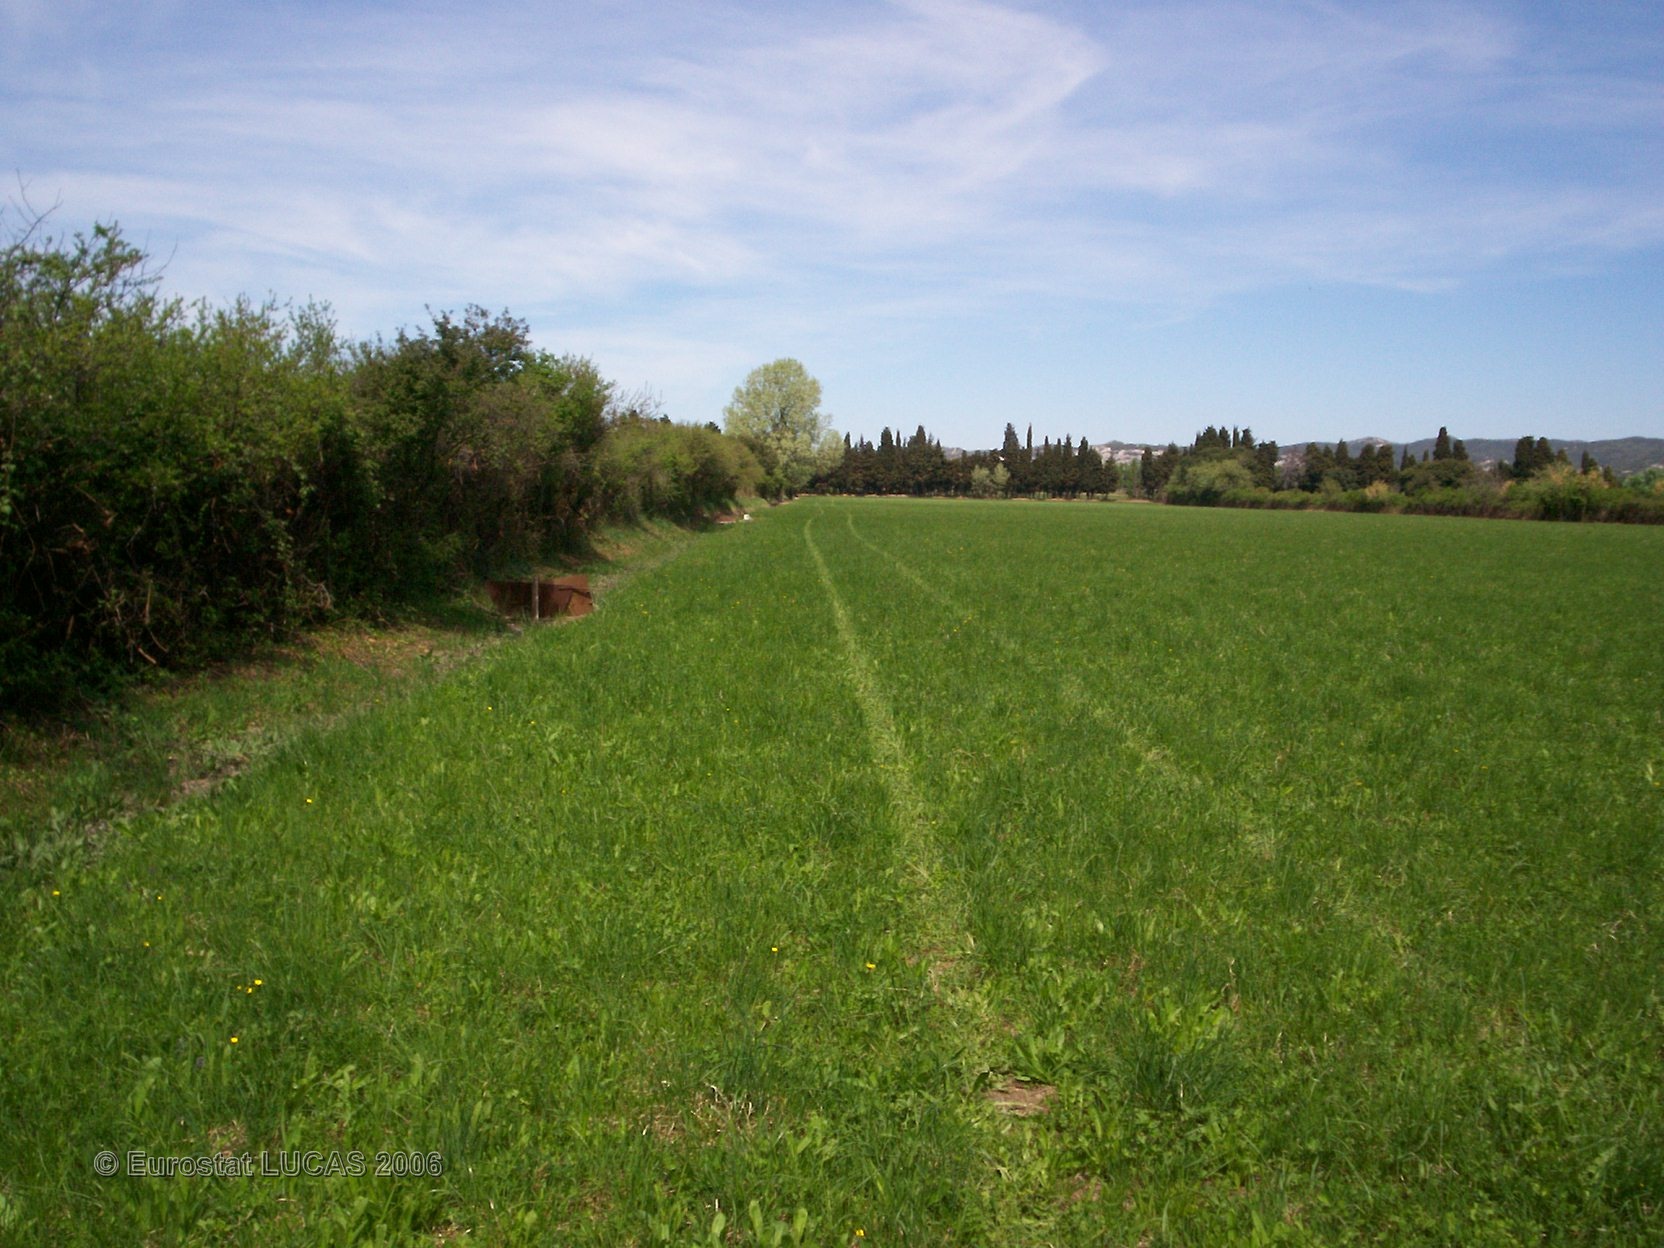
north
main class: Grassland
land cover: Grassland without tree/shrub cover
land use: Agriculture (excluding fallow land and kitchen gardens)
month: April
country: FR
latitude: 43.6835
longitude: 4.9109
